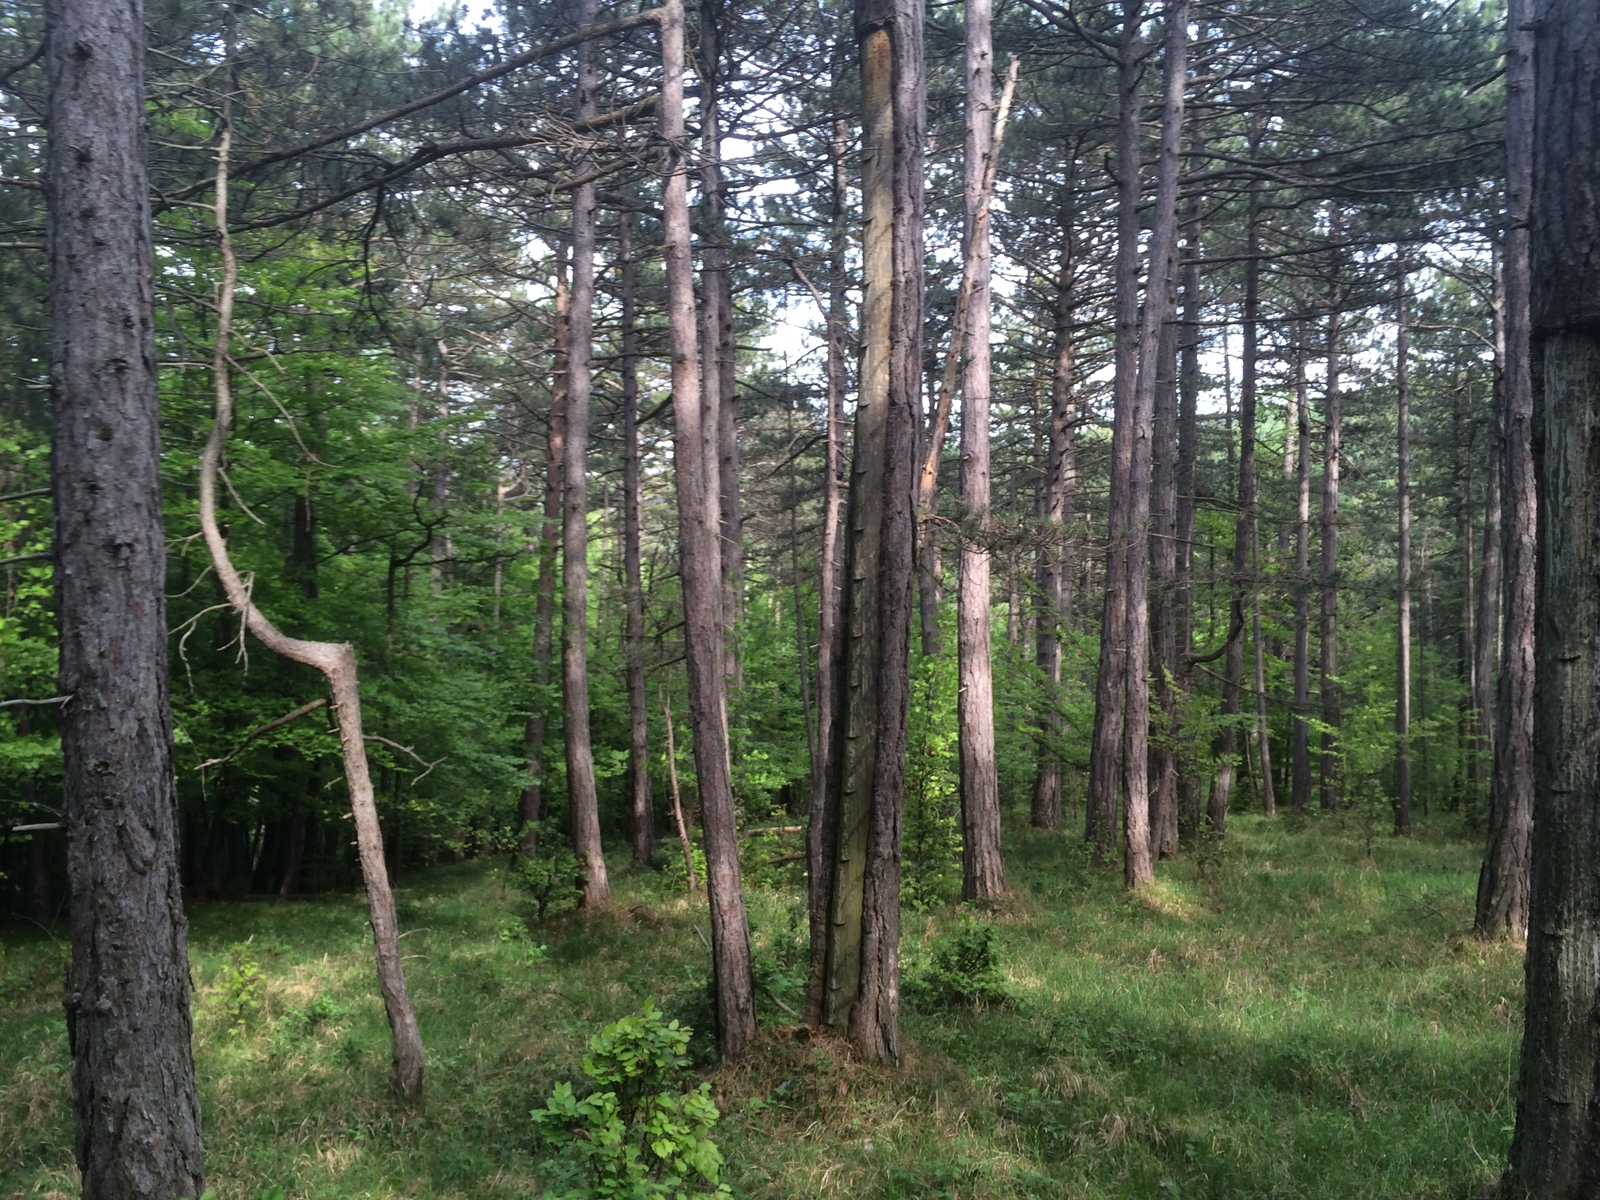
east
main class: Woodland
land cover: Pine dominated coniferous woodland
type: alpine coniferous forest
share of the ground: > 75 %
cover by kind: coniferous forest trees 95 %, broadleaved forest trees 5 %
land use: Forestry
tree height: > 5 m
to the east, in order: Pine dominated coniferous woodland; Pine dominated mixed woodland; Broadleaved woodland; Grassland without tree/shrub cover; Electric lines; Grassland without tree/shrub cover; Broadleaved woodland; Grassland without tree/shrub cover; Electric lines; Grassland without tree/shrub cover; Shruby margins; Tracks; Groves; Rivers and streams; Broadleaved woodland
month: May
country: AT
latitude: 47.9108
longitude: 16.0911
